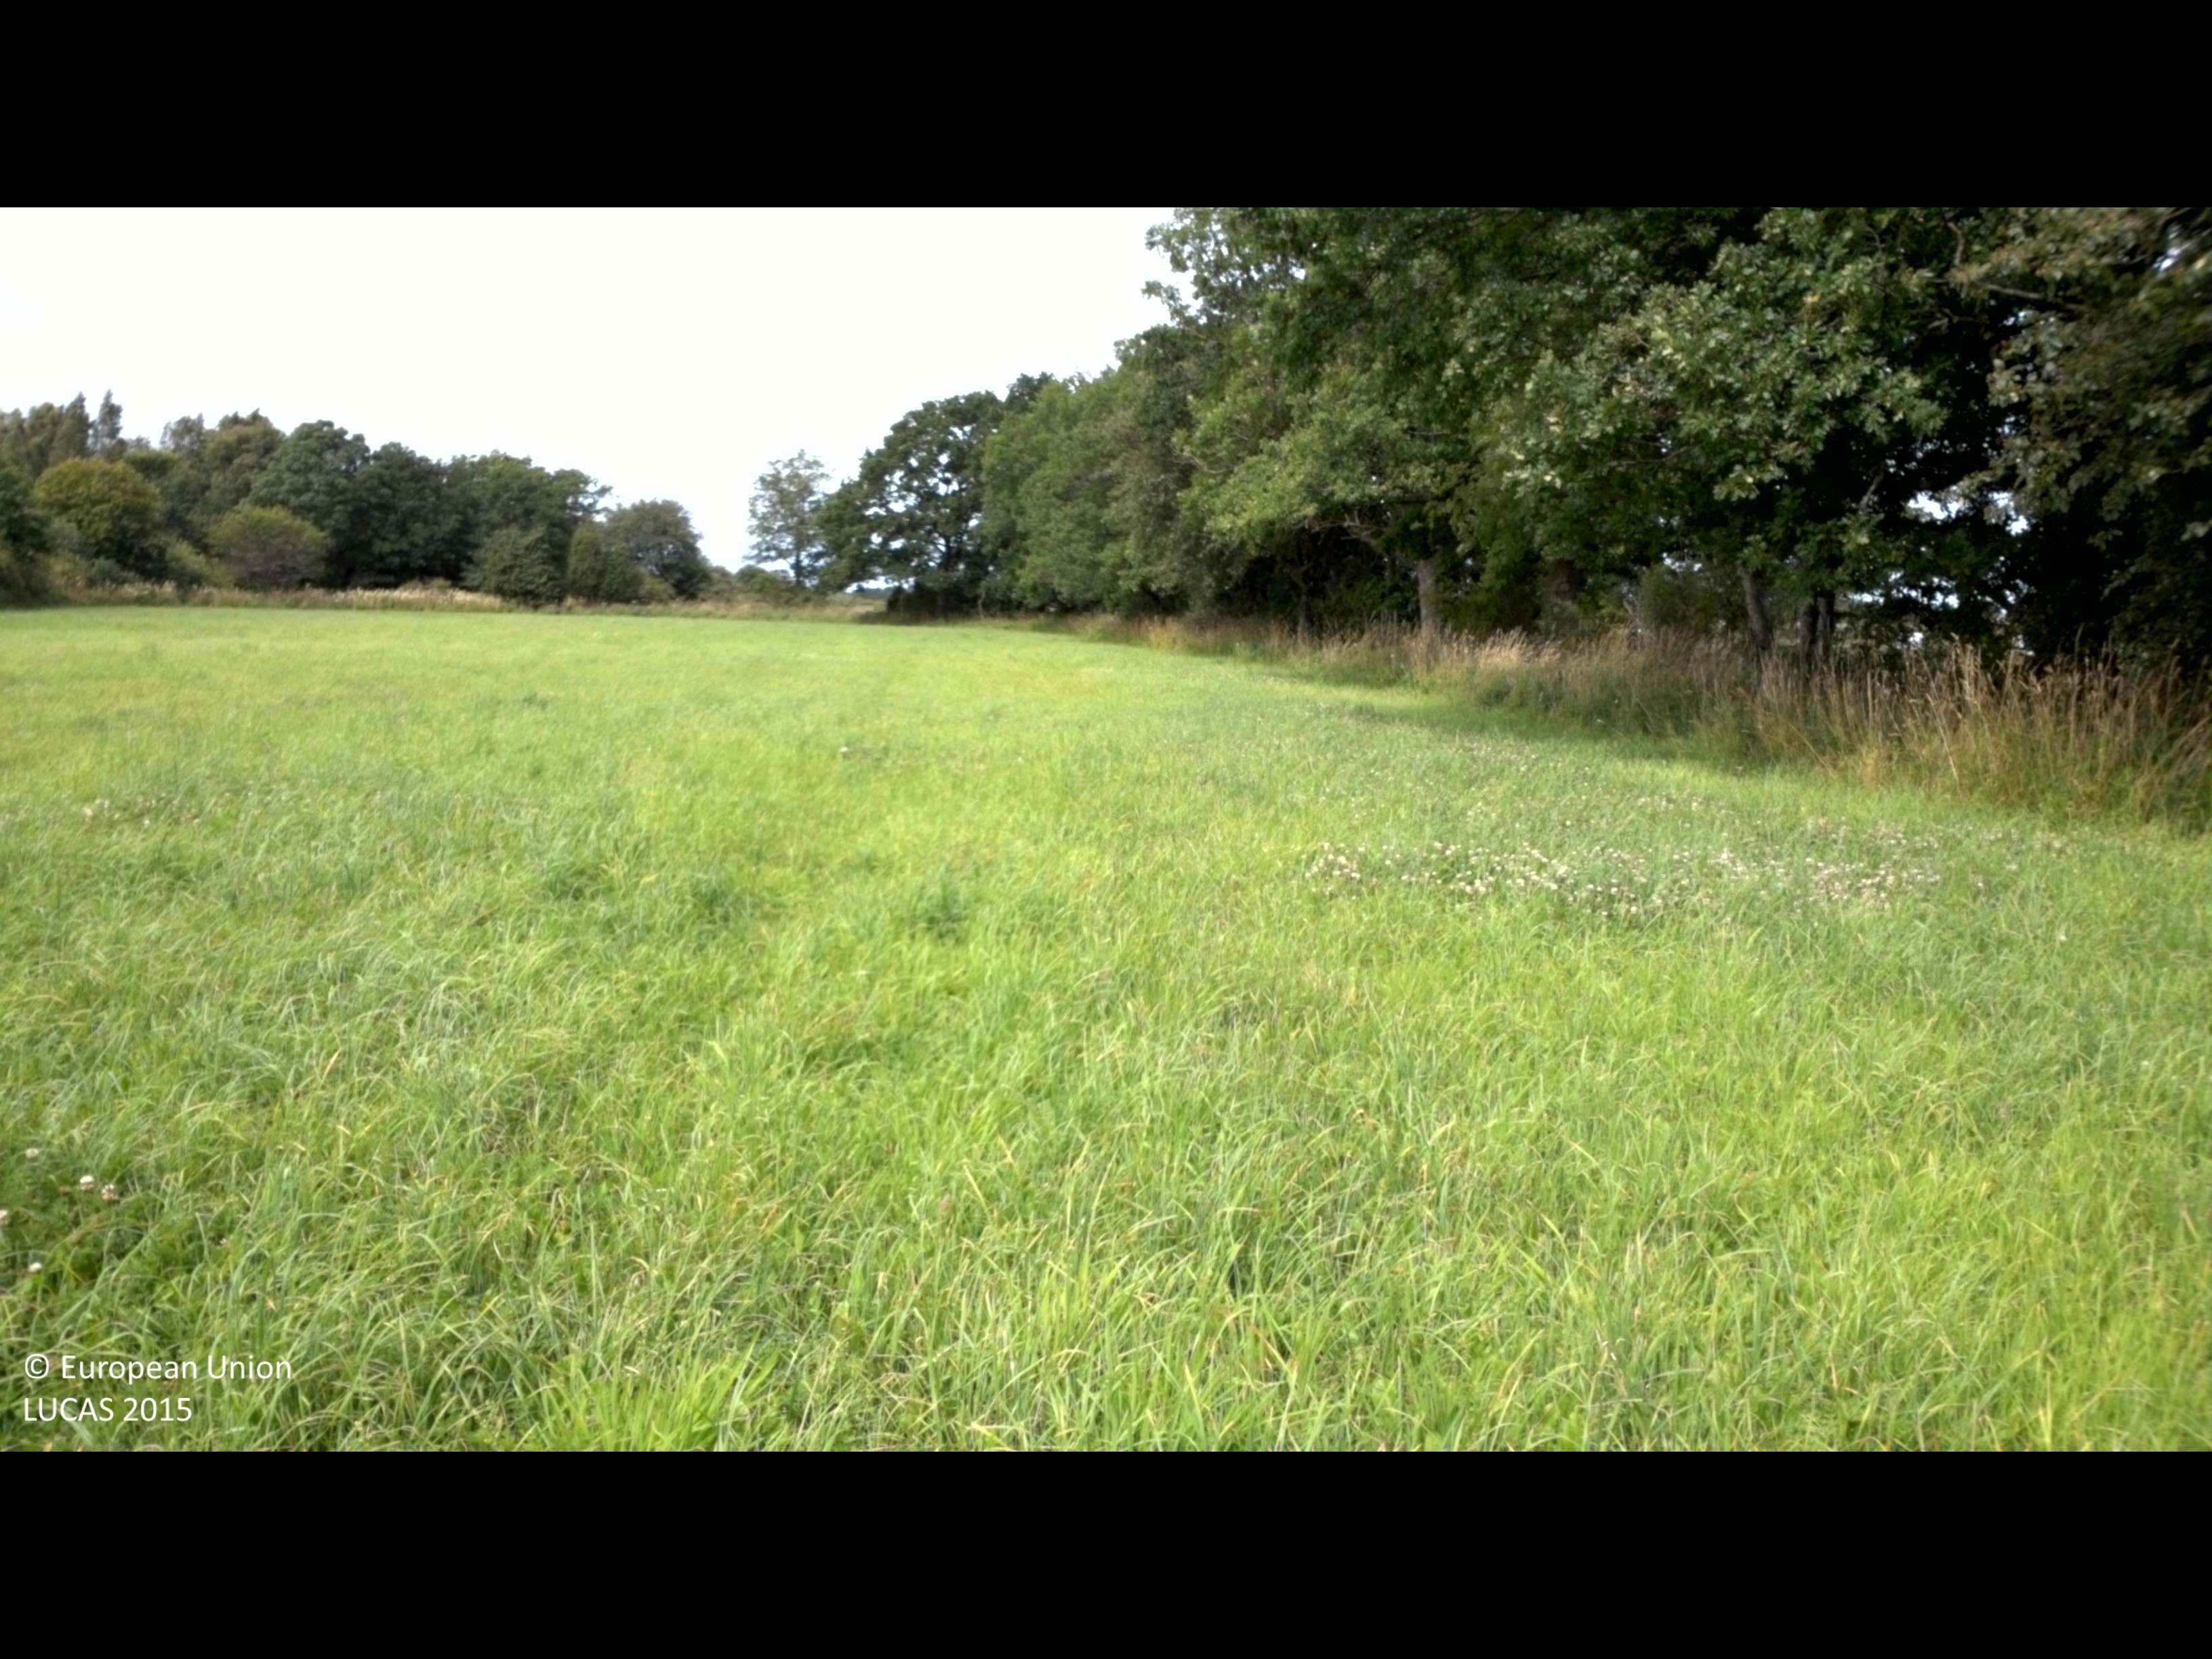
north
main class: Grassland
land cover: Grassland without tree/shrub cover
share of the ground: > 75 %
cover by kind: herbaceous plants 100 %
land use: Agriculture (excluding fallow land and kitchen gardens)
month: July
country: SE
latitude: 57.0486
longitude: 16.9088
